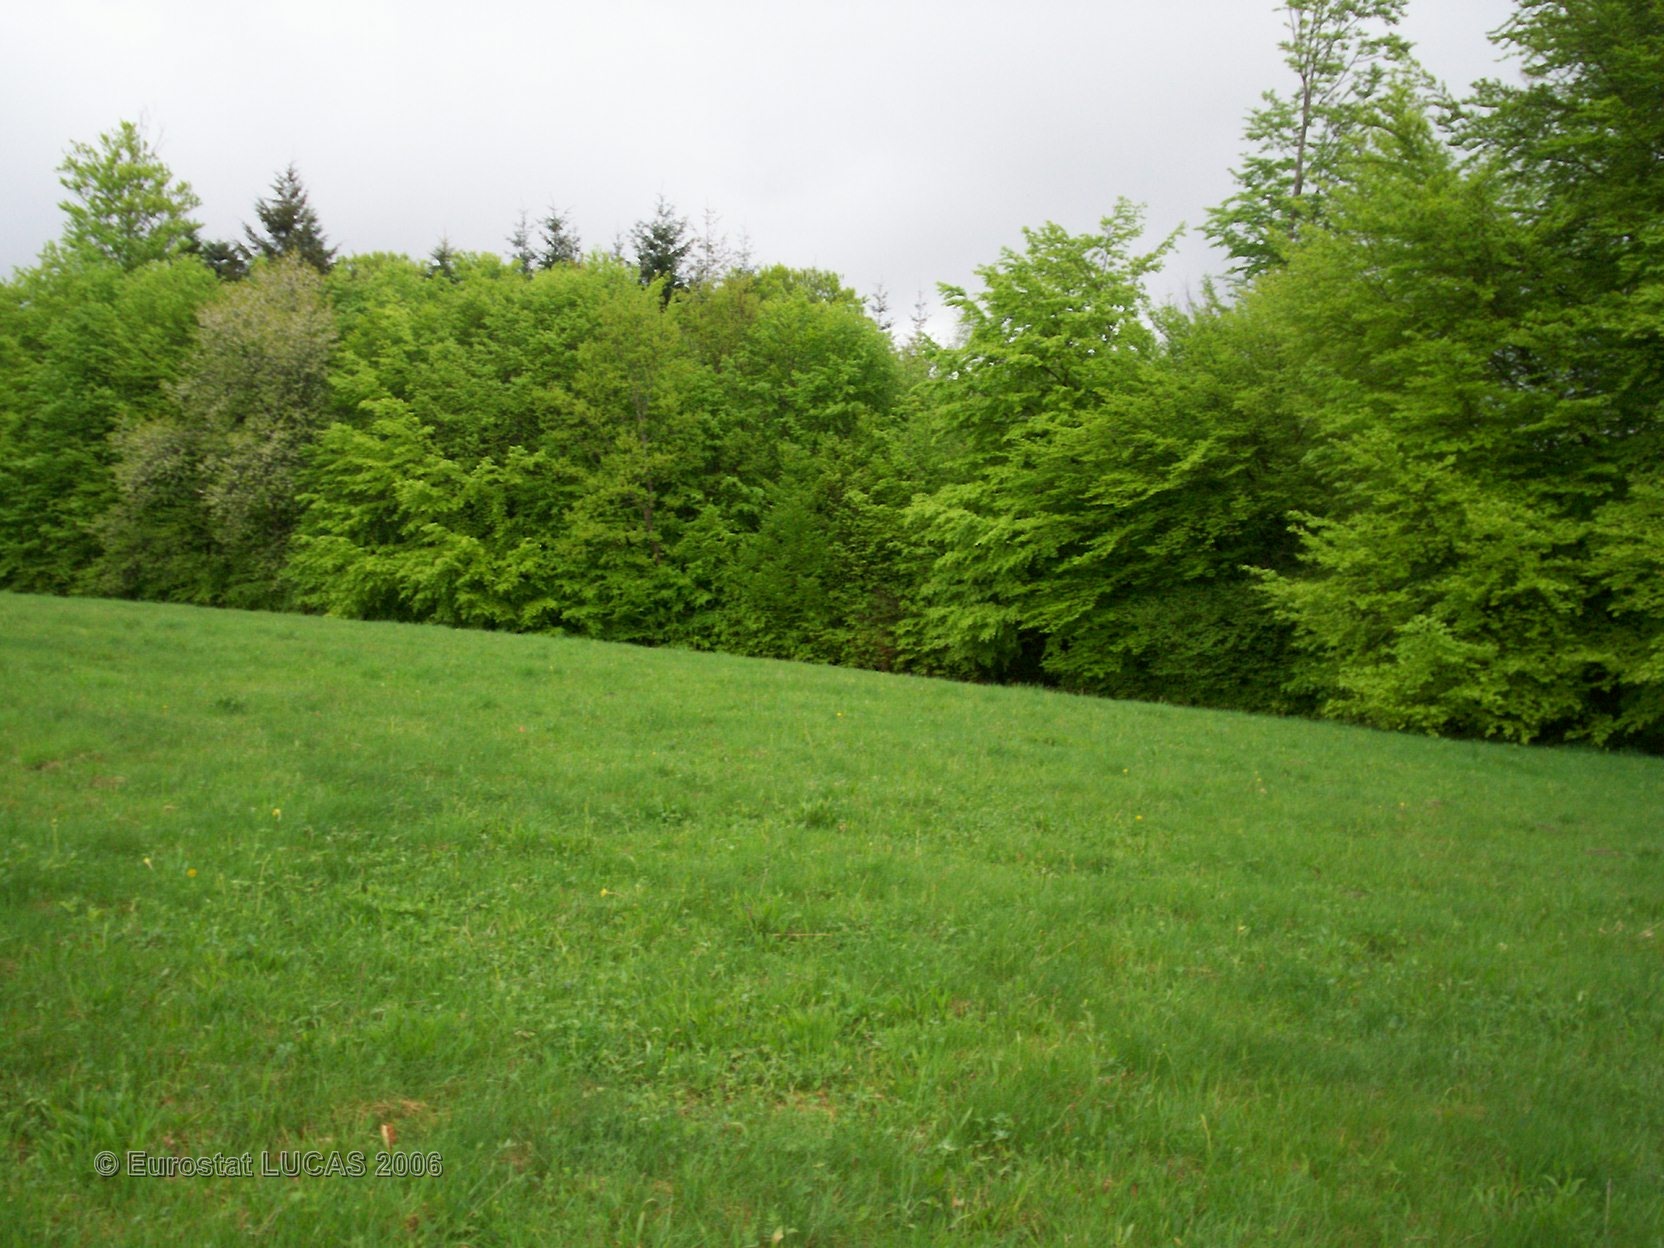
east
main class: Grassland
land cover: Grassland without tree/shrub cover
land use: Agriculture (excluding fallow land and kitchen gardens)
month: May
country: FR
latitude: 48.0008
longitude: 6.3419
